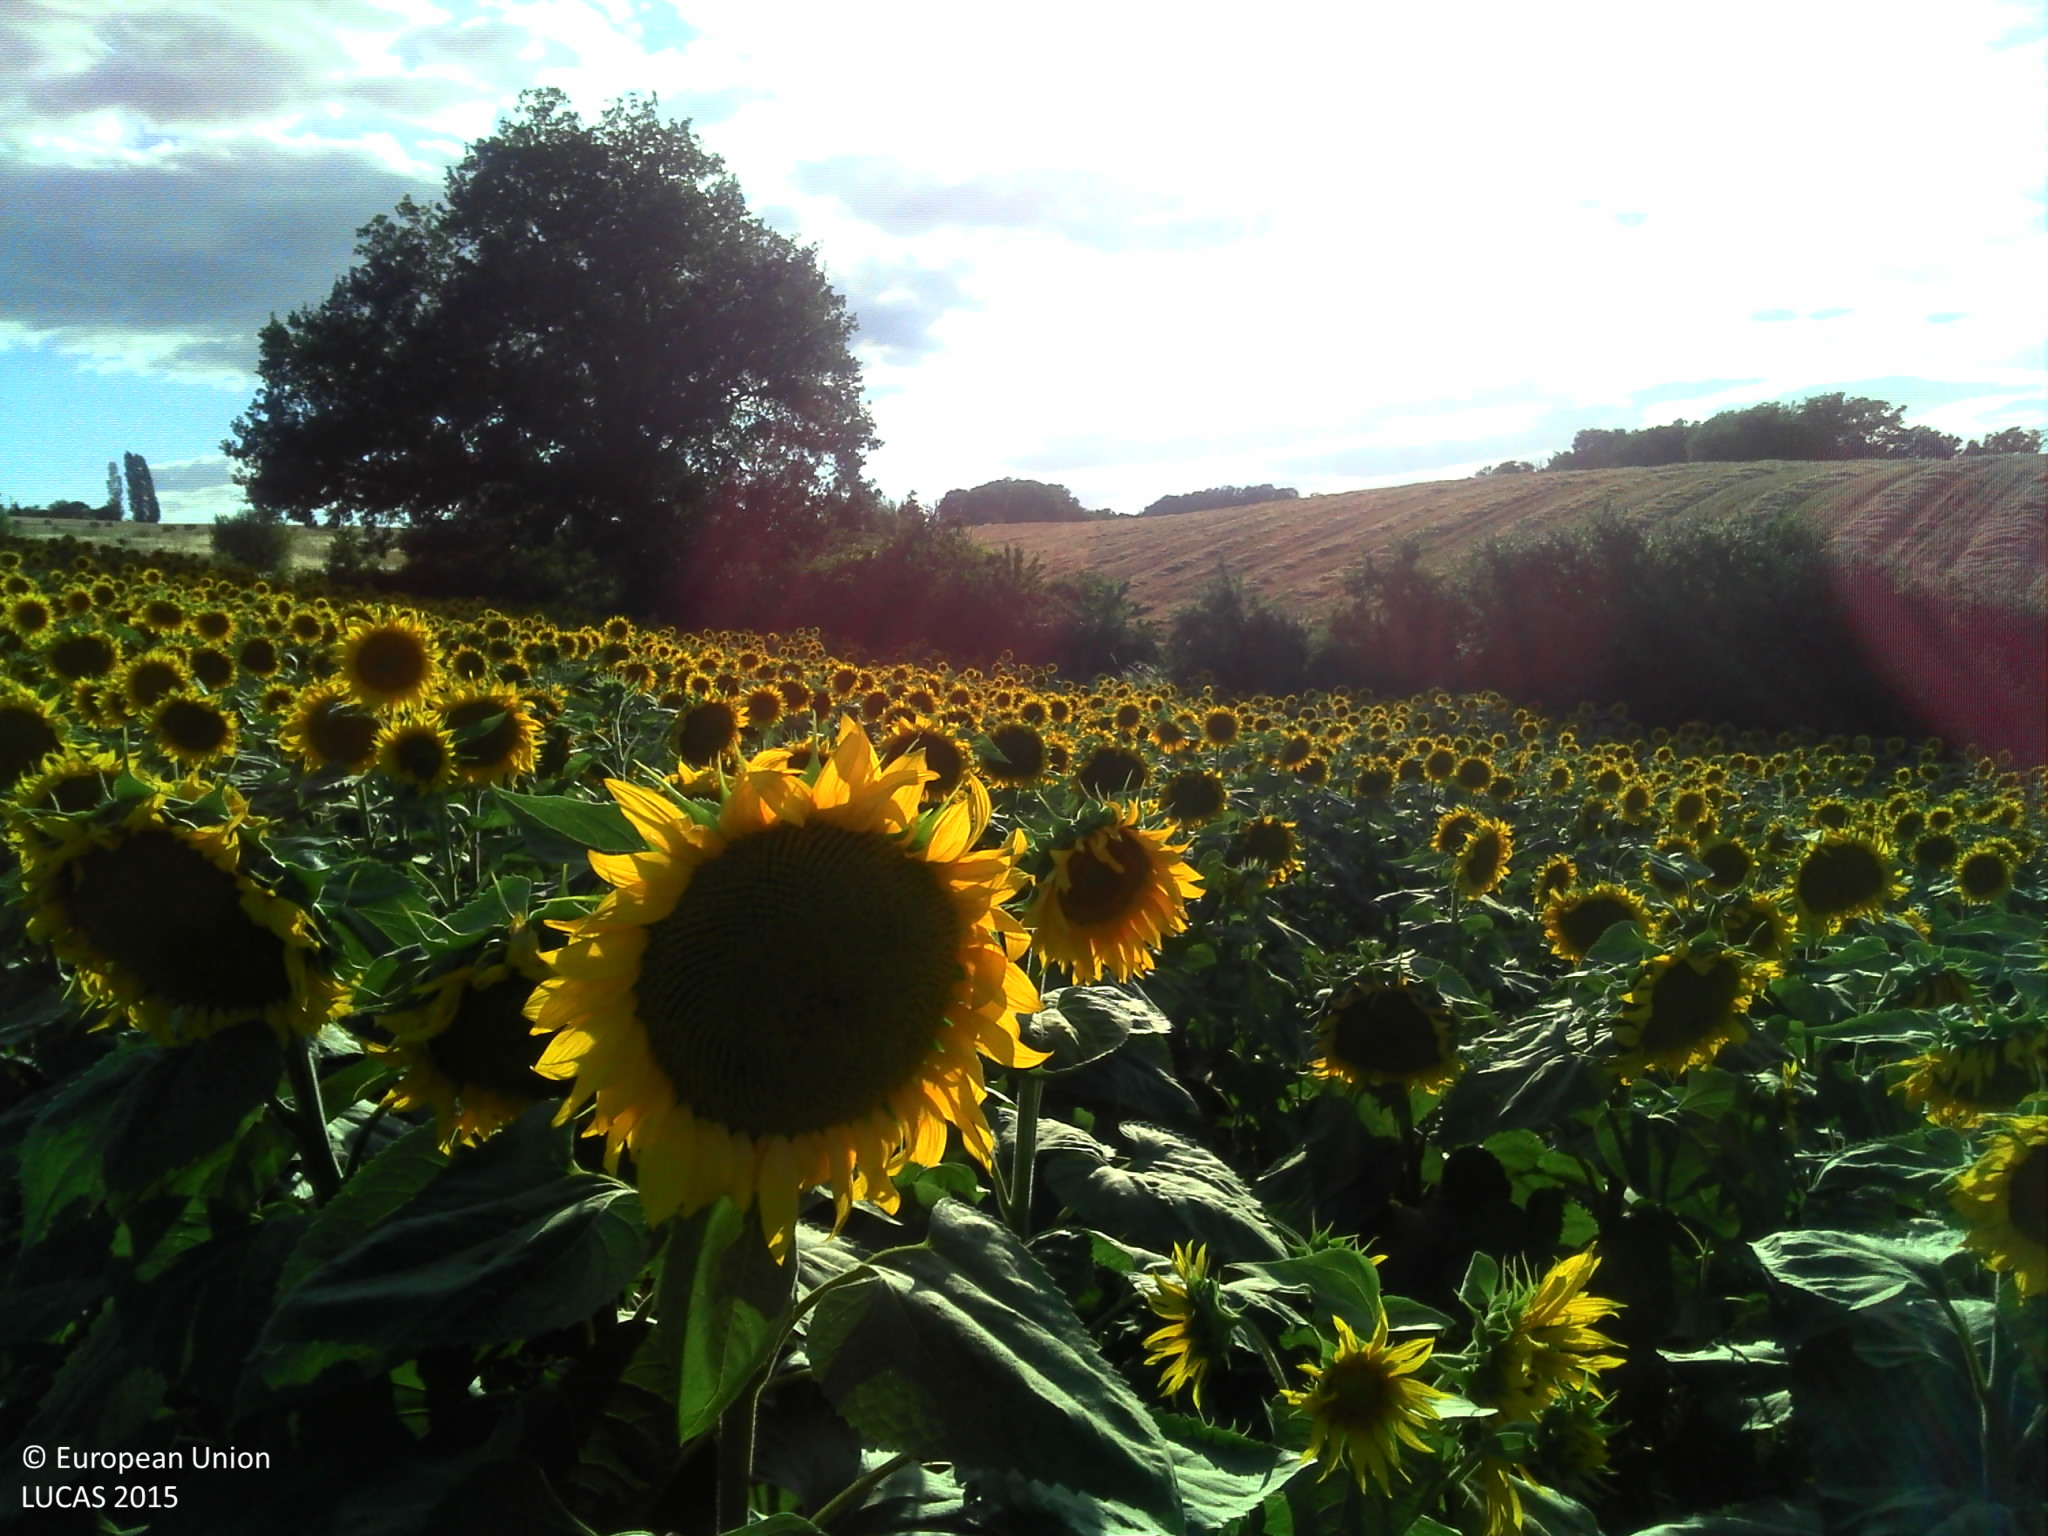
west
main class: Cropland
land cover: Sunflower
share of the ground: > 75 %
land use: Agriculture (excluding fallow land and kitchen gardens)
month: July
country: FR
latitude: 43.8596
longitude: 0.9036
